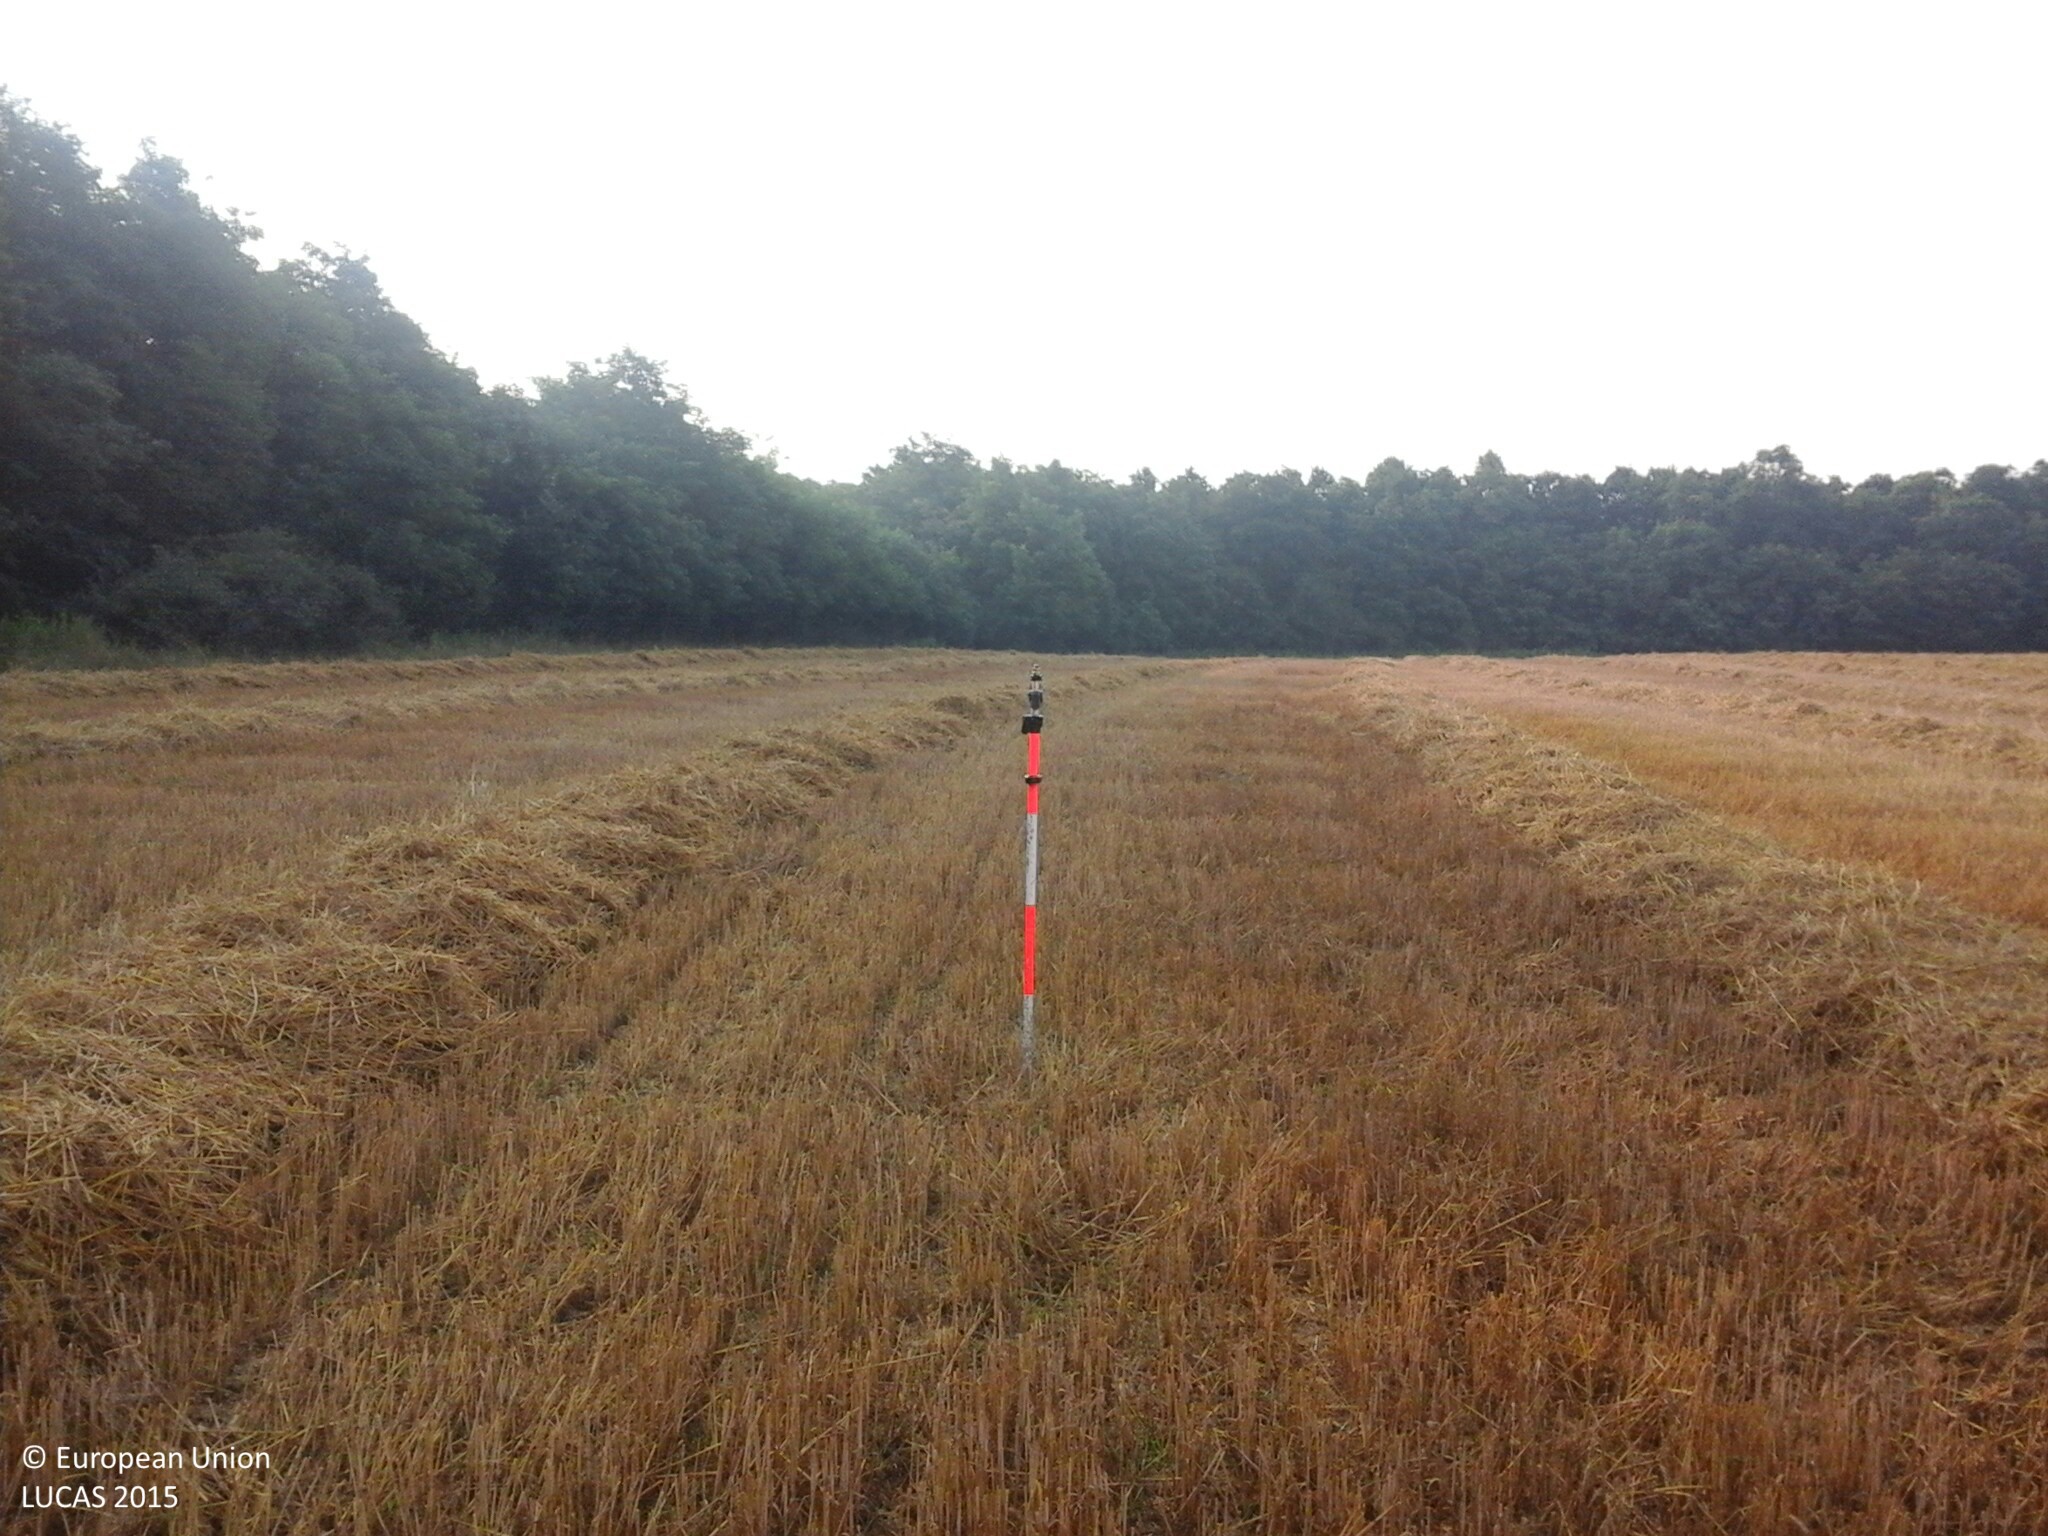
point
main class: Cropland
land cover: Triticale
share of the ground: 50 - 75 %
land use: Agriculture (excluding fallow land and kitchen gardens)
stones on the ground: < 10 %
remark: Harvested field
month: August
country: HU
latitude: 47.4339
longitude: 18.1389
